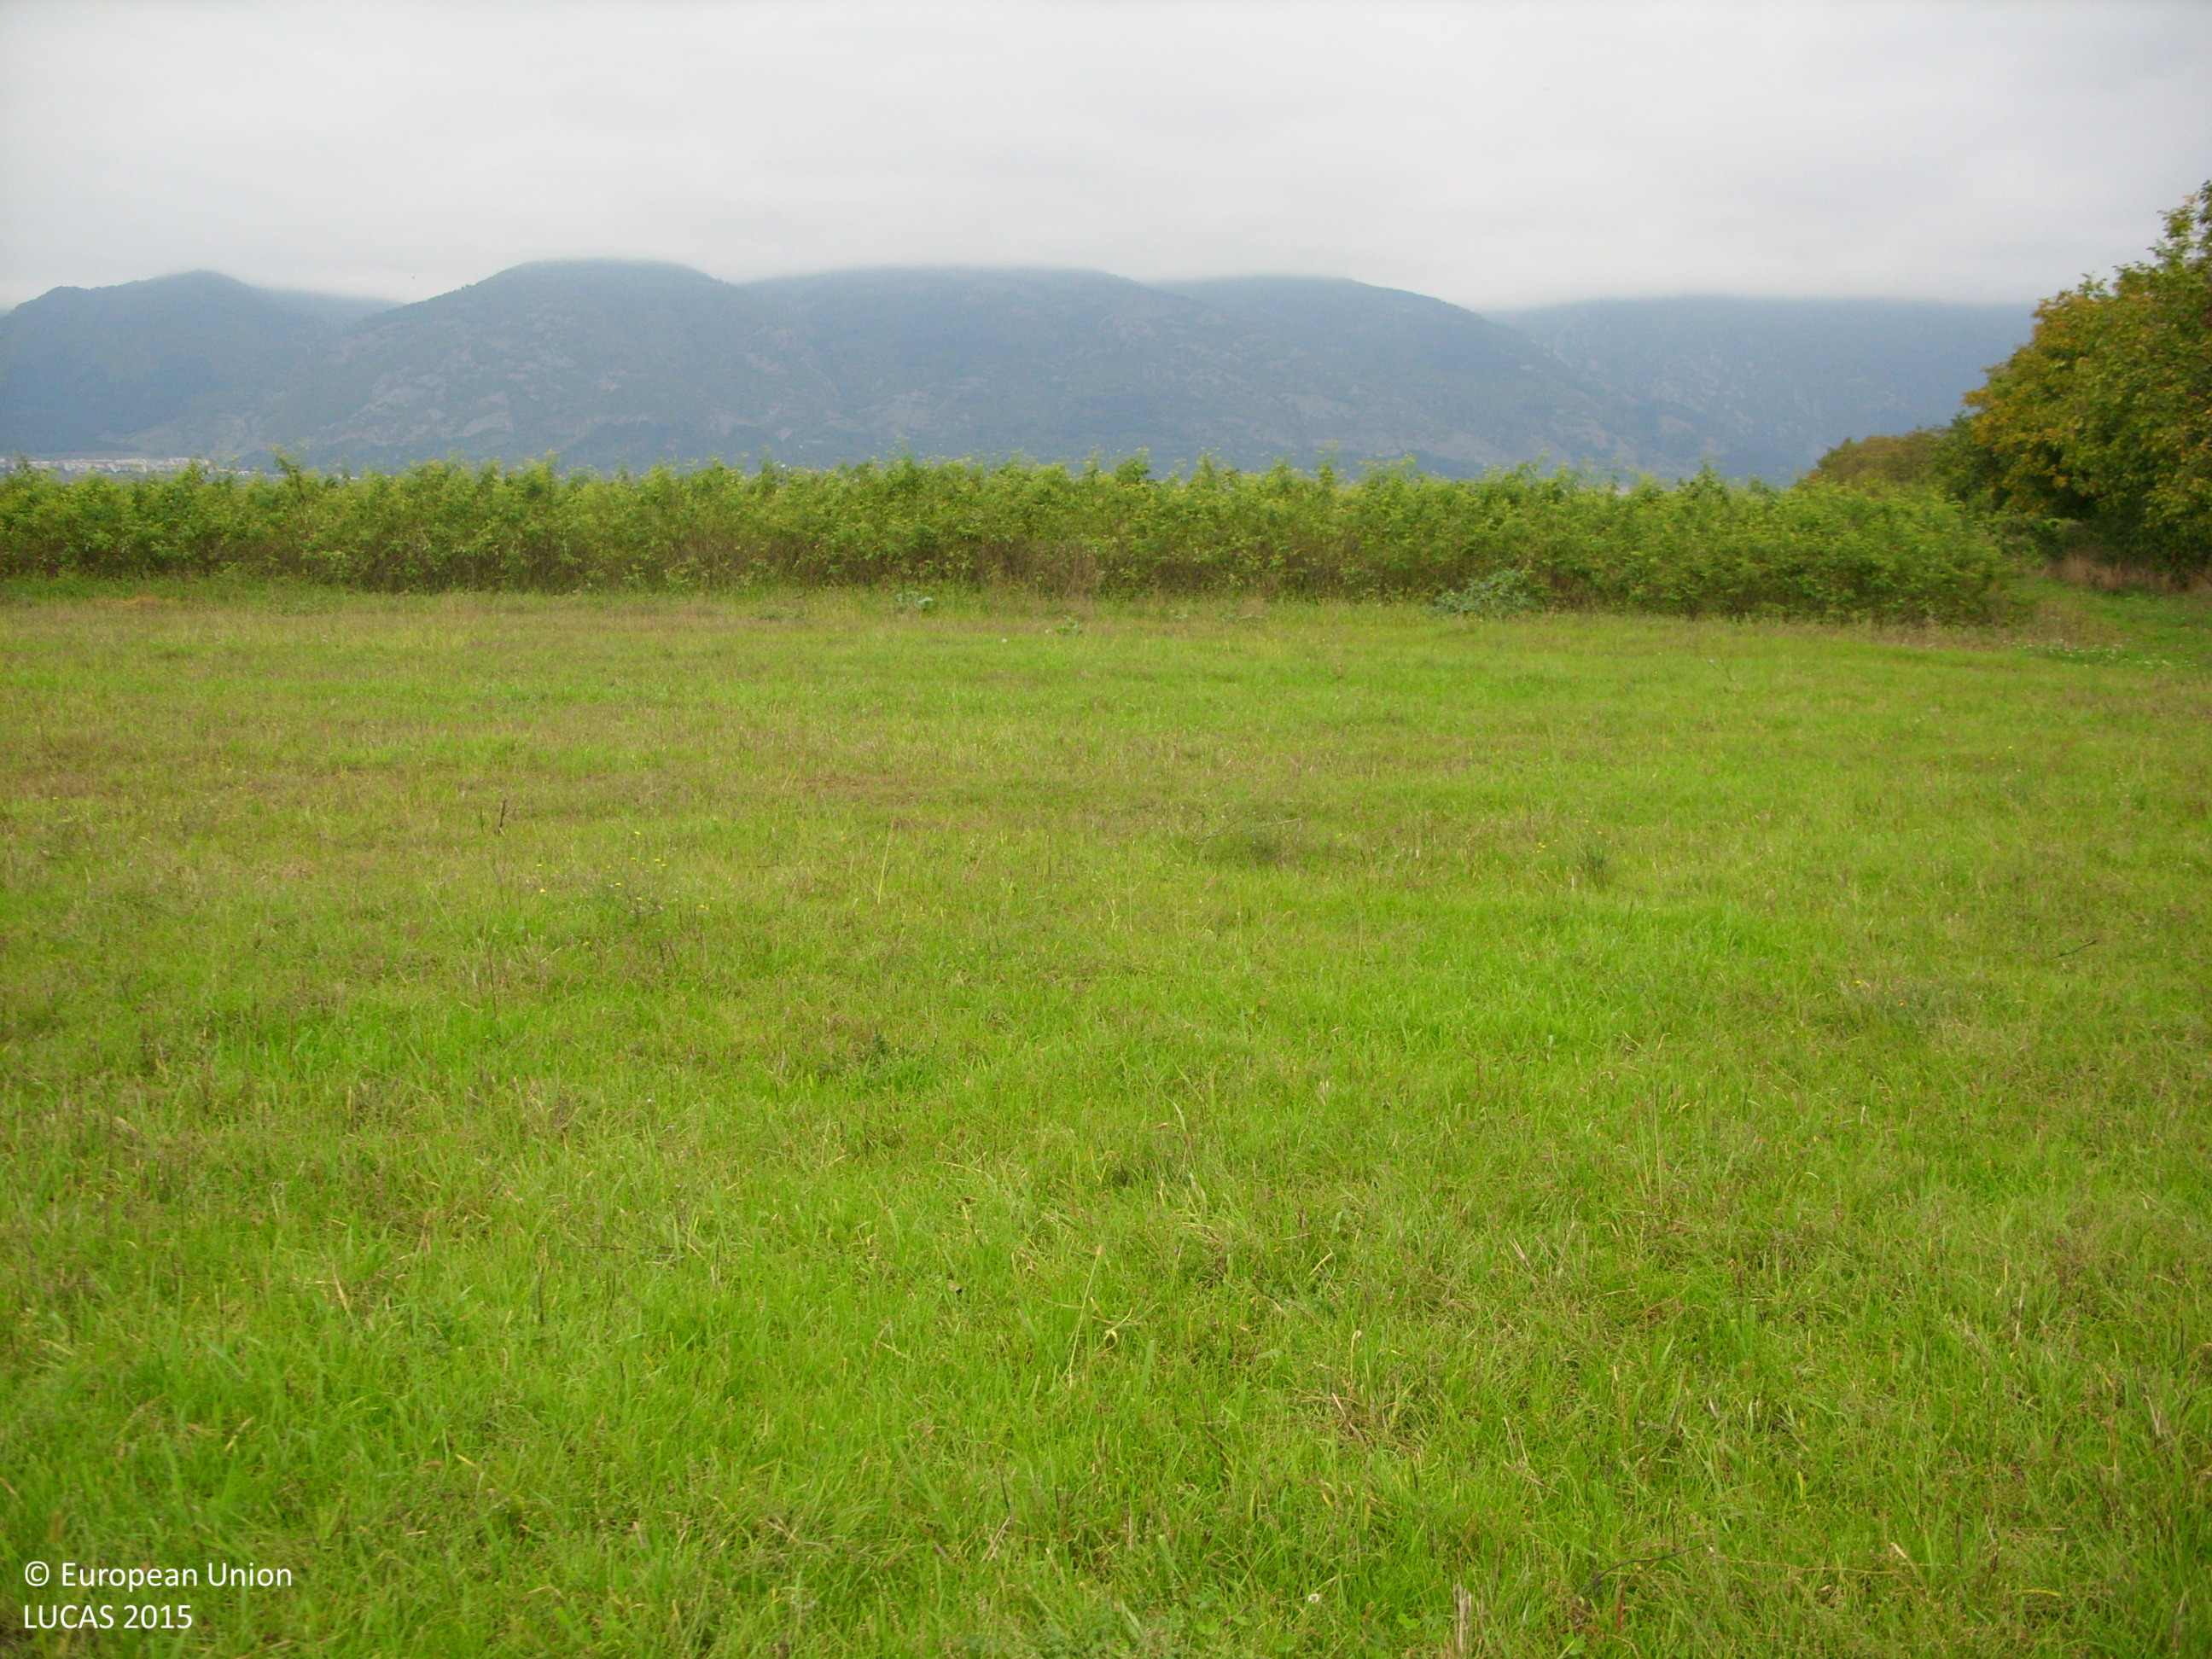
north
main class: Grassland
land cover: Grassland without tree/shrub cover
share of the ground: > 75 %
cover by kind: herbaceous plants 100 %
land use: Agriculture (excluding fallow land and kitchen gardens)
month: October
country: BG
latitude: 42.6089
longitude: 24.7701
